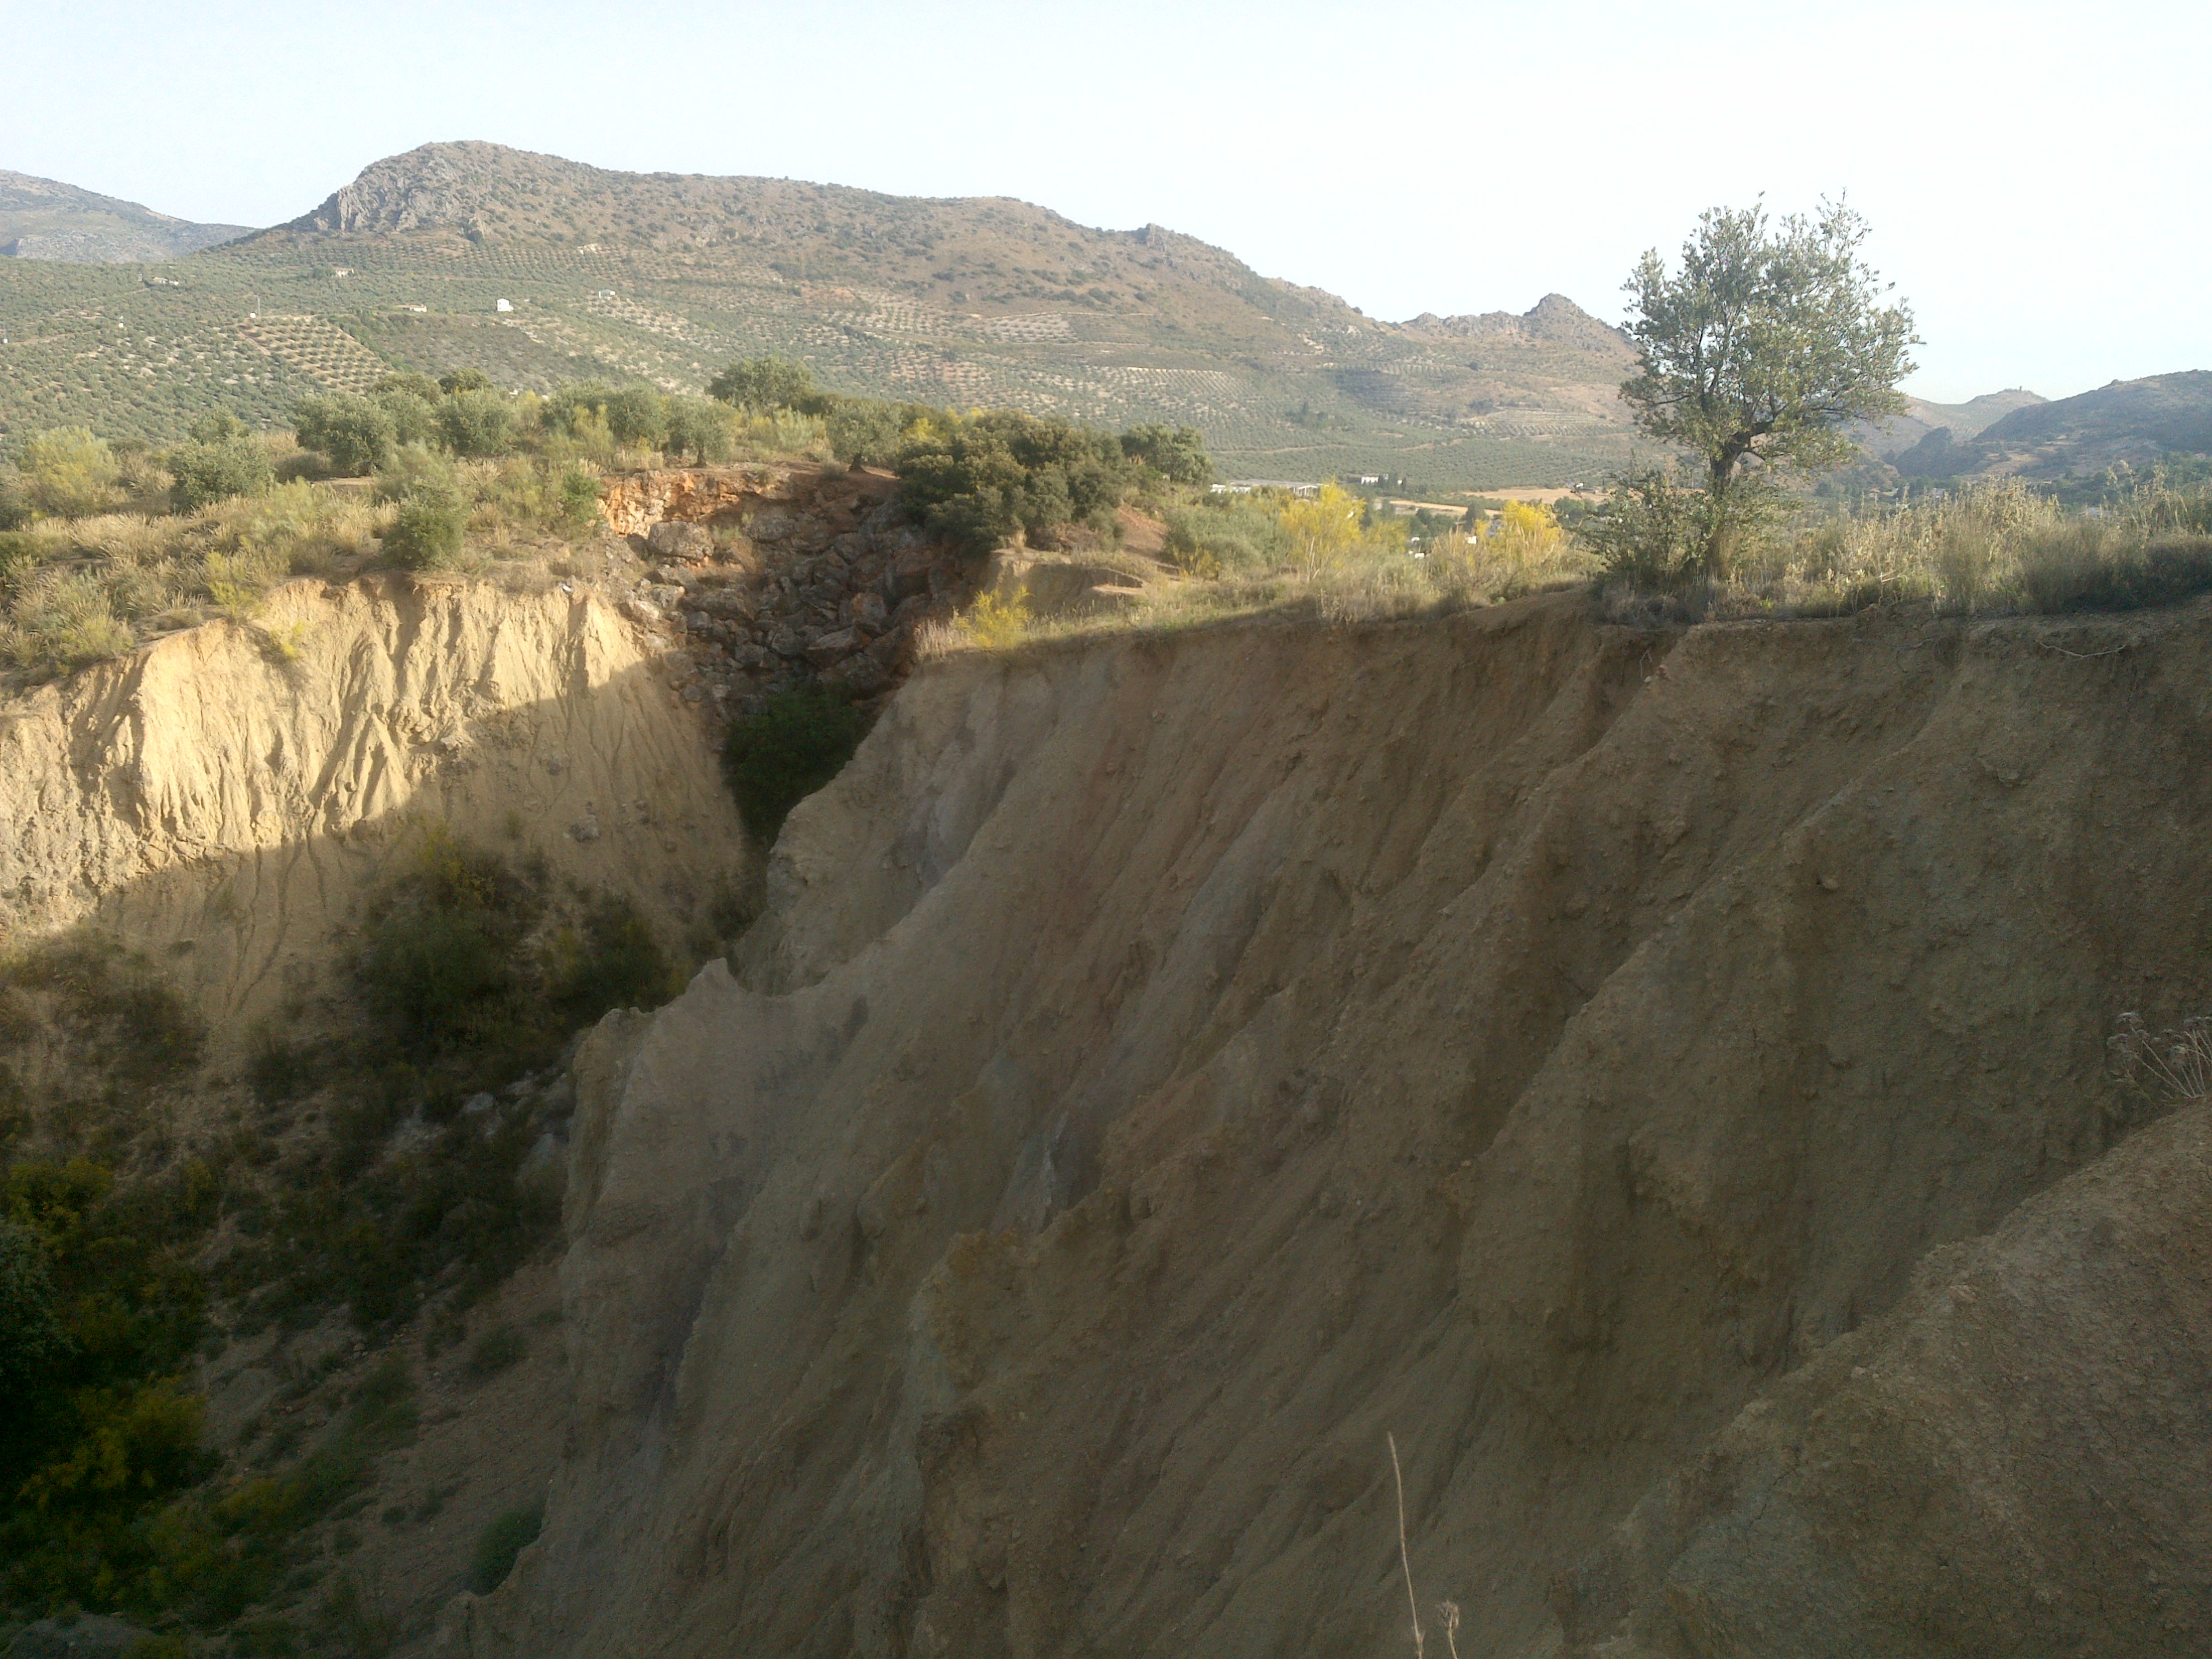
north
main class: Shrubland
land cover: Shrubland with sparse tree cover
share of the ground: 25 - 50 %
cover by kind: unconsolidated bare surface 35 %, shrubs 30 %, herbaceous plants 30 %, broadleaved forest trees 5 %
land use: Abandoned areas
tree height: < 5 m
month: May
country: ES
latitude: 37.4500
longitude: -4.1863
